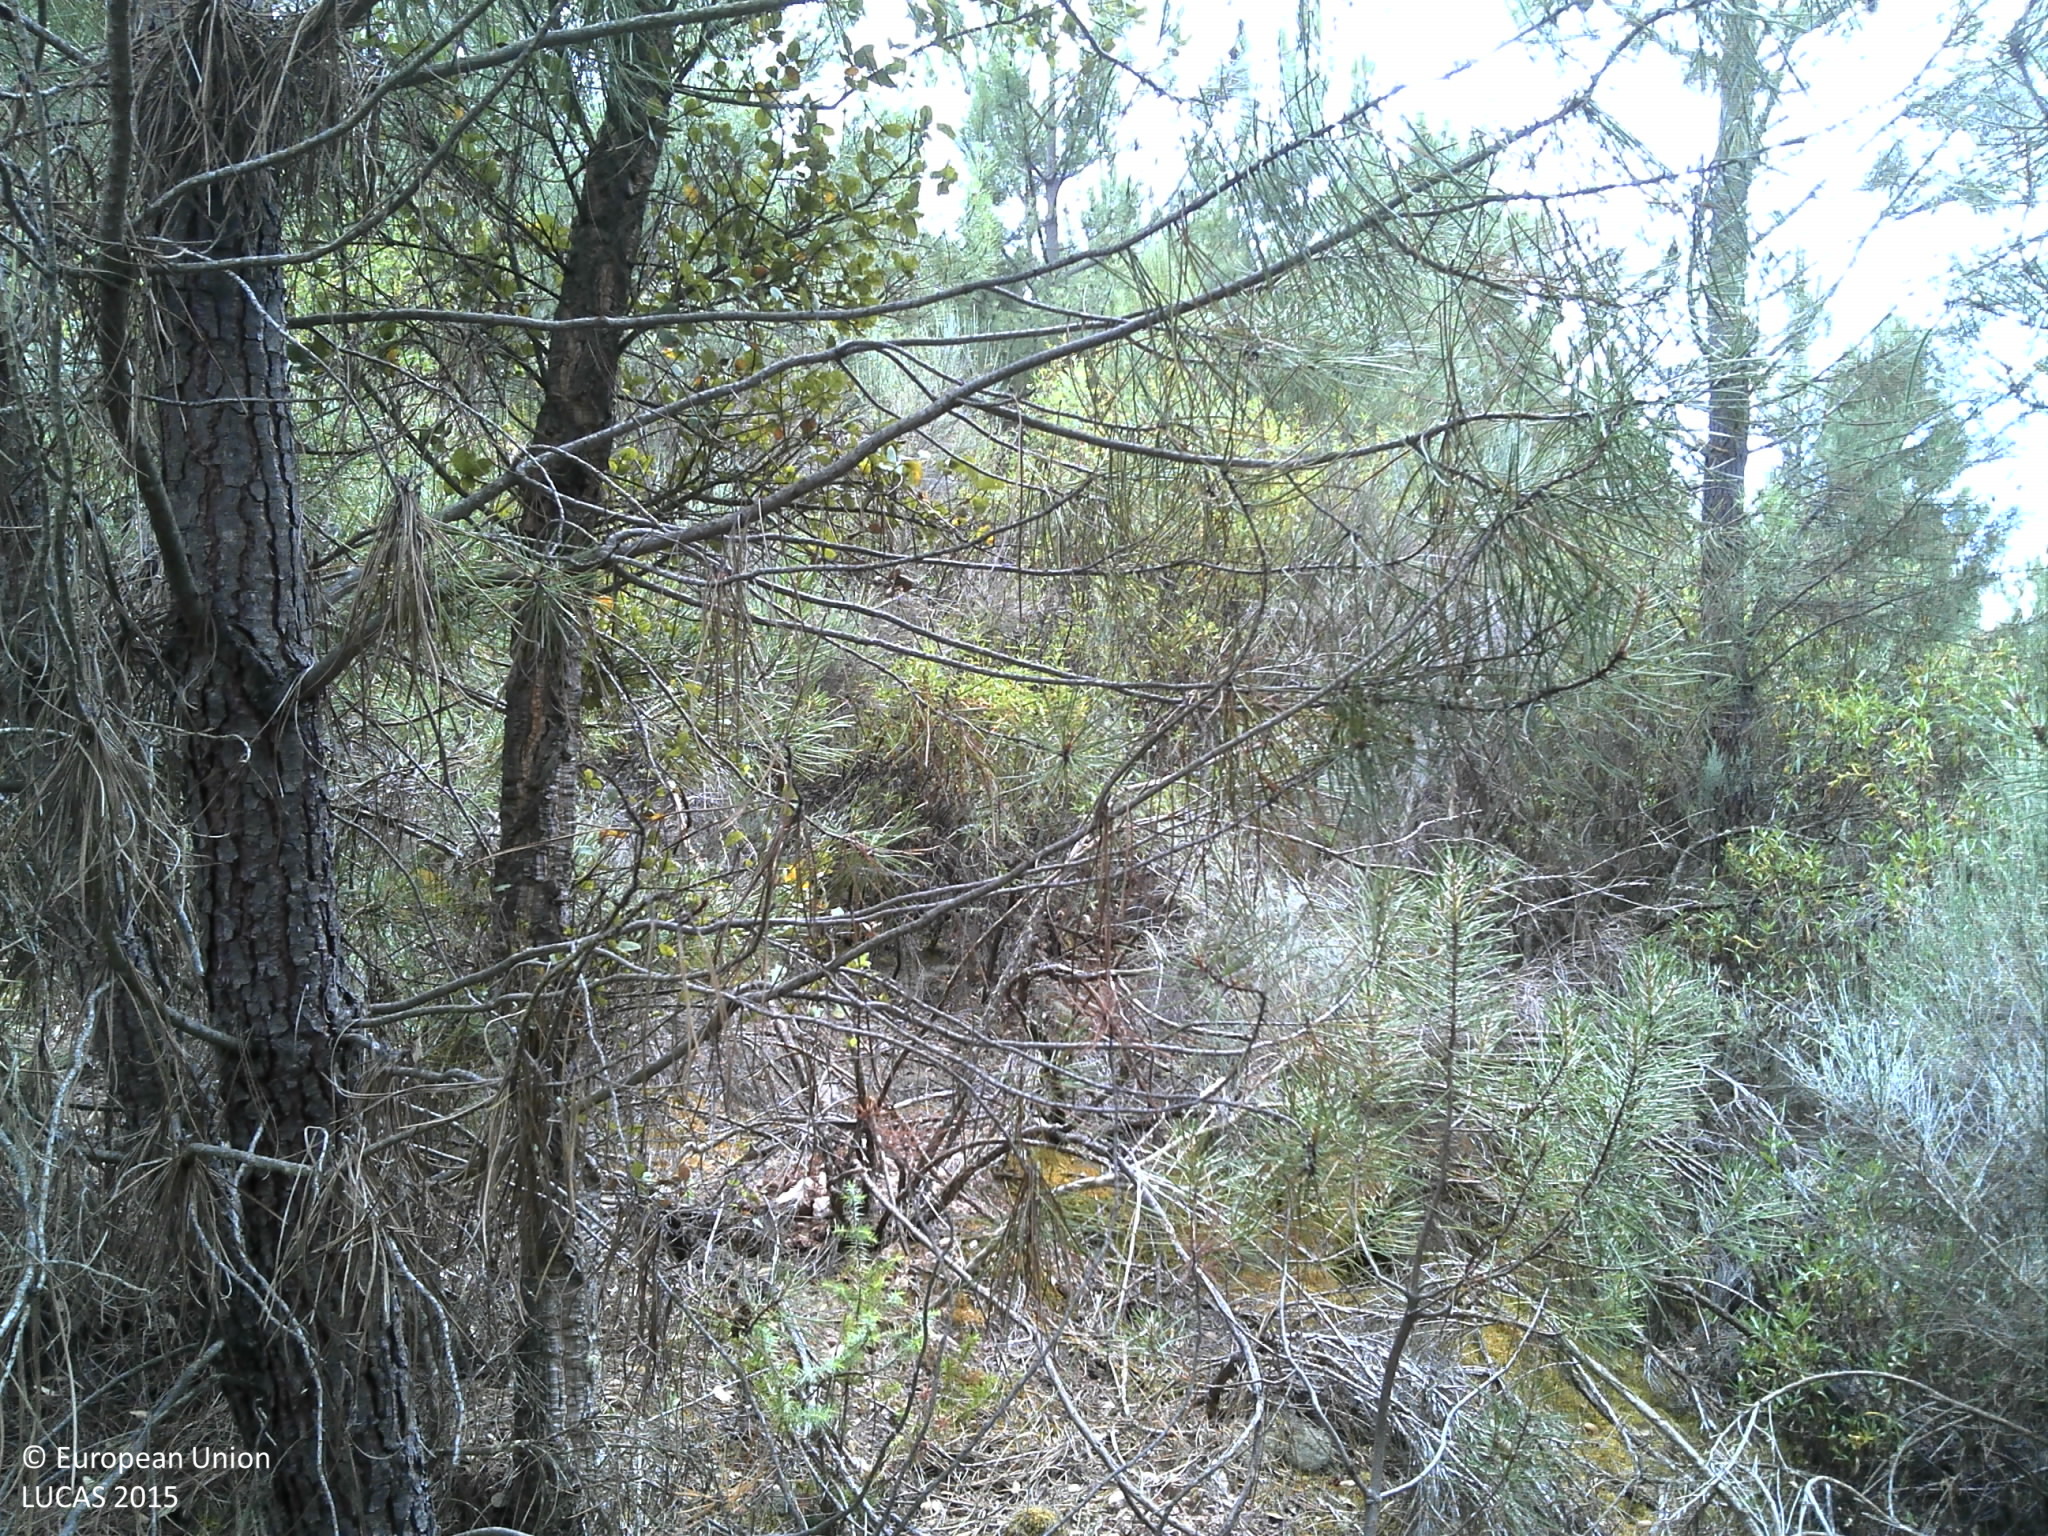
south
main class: Woodland
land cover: Pine dominated coniferous woodland
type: coniferous forest of the mediterranean region
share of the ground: 25 - 50 %
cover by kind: shrubs 55 %, coniferous forest trees 25 %, unconsolidated bare surface 20 %
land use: Forestry
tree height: > 5 m
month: June
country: PT
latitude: 41.2638
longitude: -6.9762
